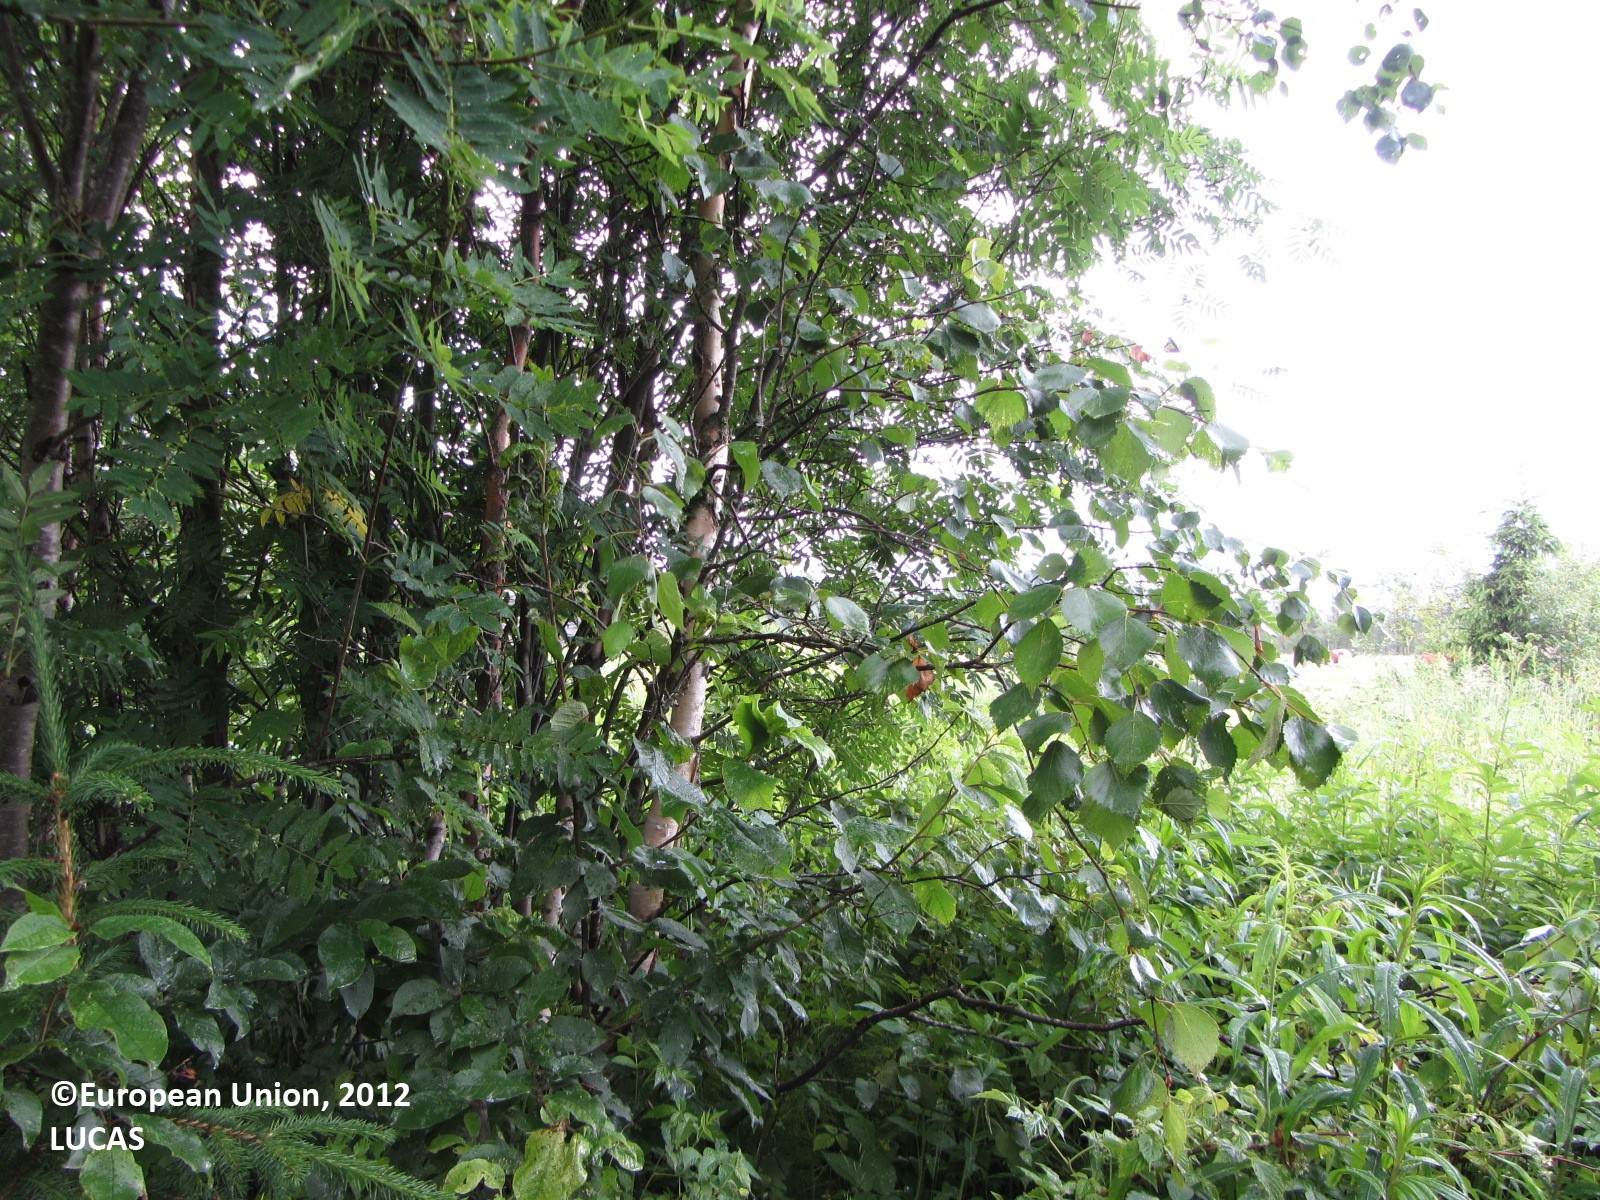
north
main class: Woodland
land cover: Broadleaved woodland
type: boreal forest
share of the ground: 50 - 75 %
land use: Forestry
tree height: > 5 m
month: July
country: FI
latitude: 63.8092
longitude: 25.5532
